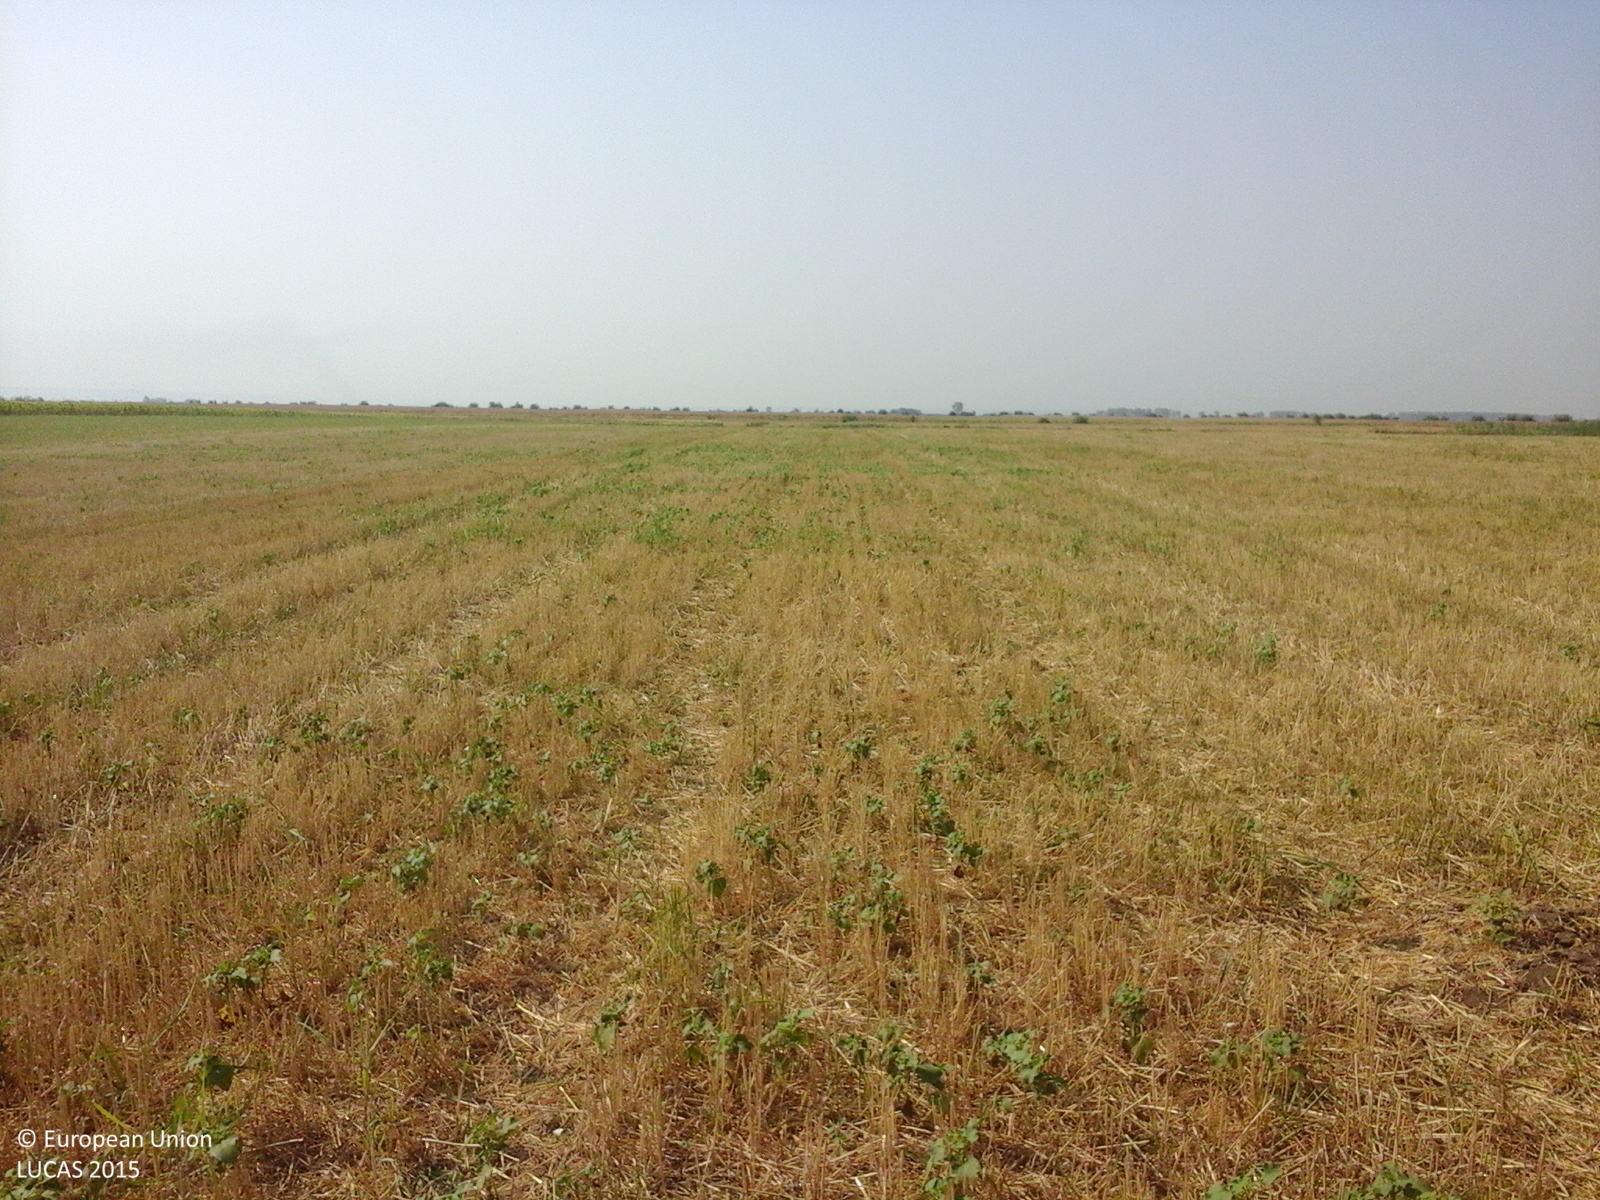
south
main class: Cropland
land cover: Common wheat
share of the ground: > 75 %
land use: Agriculture (excluding fallow land and kitchen gardens)
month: August
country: RO
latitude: 43.9574
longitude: 23.2166
